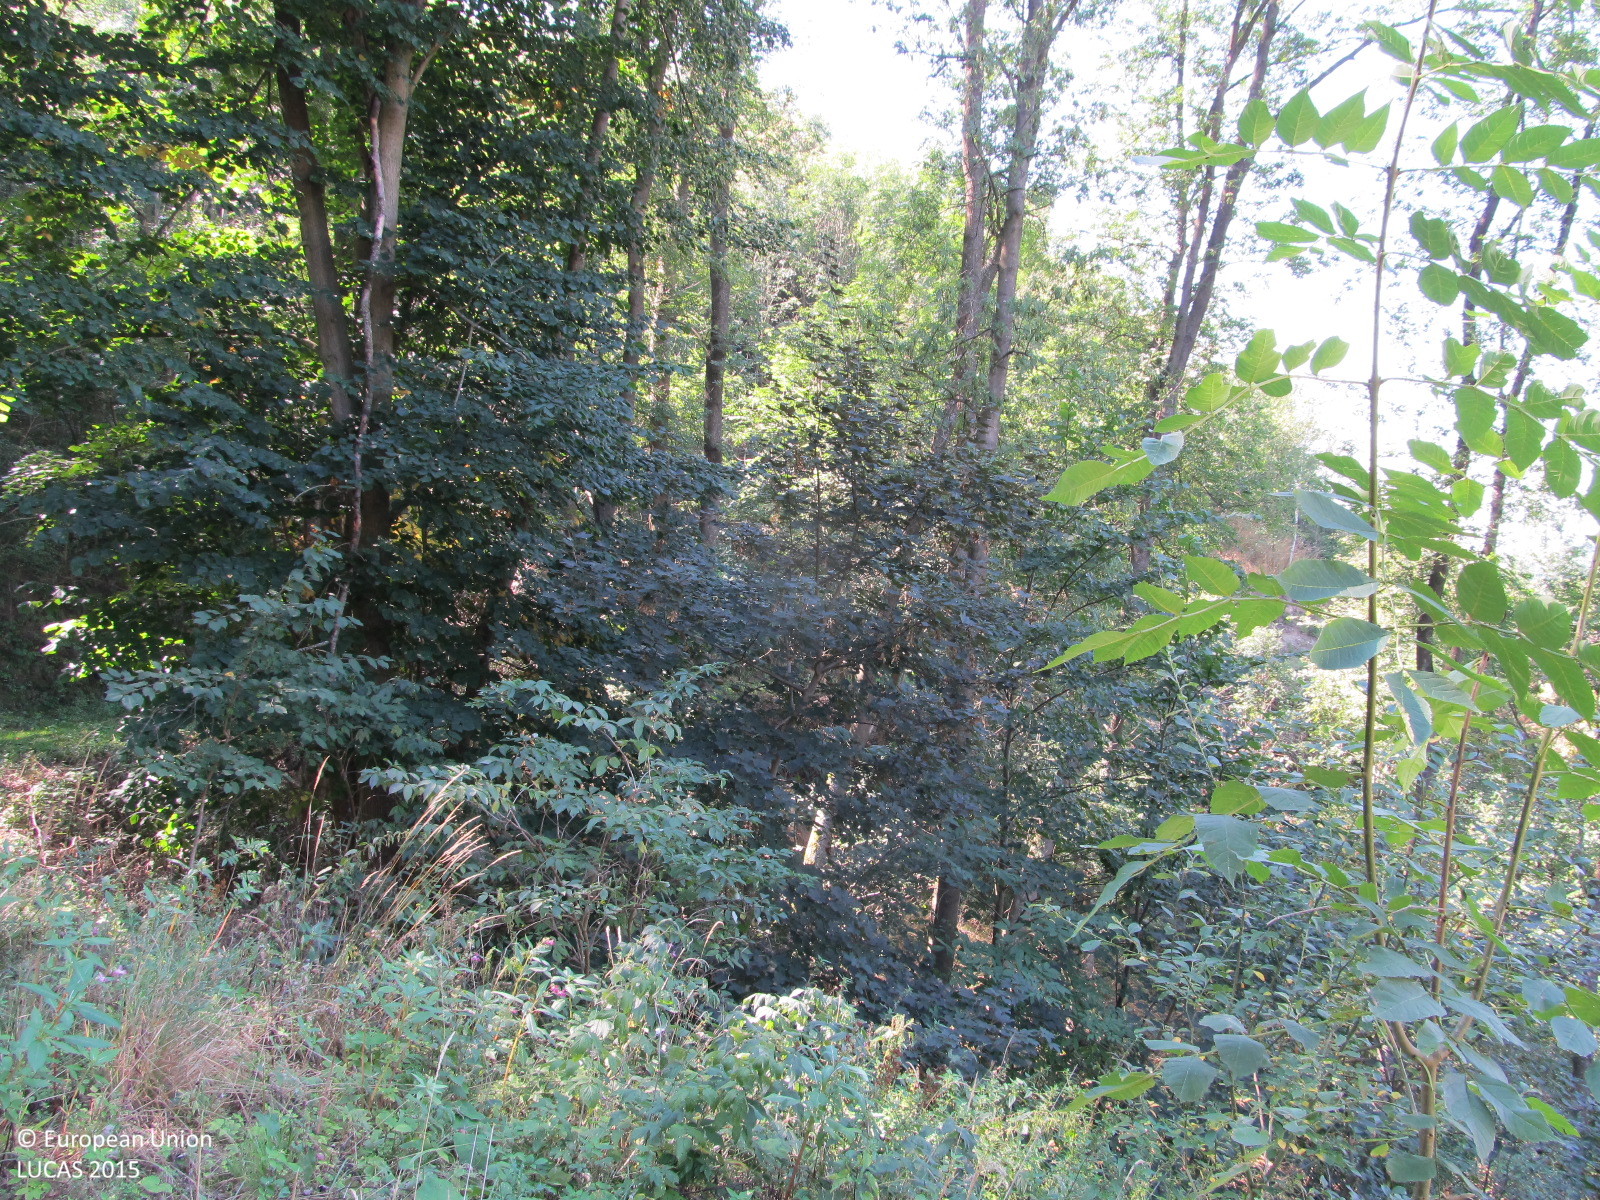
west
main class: Woodland
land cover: Broadleaved woodland
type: hemiboreal forest and nemoral coniferous forest and mixed broadleaved-coniferous forest
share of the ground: 25 - 50 %
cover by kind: herbaceous plants 55 %, broadleaved forest trees 25 %, shrubs 20 %
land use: Semi-natural and natural areas not in use
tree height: > 5 m
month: August
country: AT
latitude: 48.8247
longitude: 15.5197
